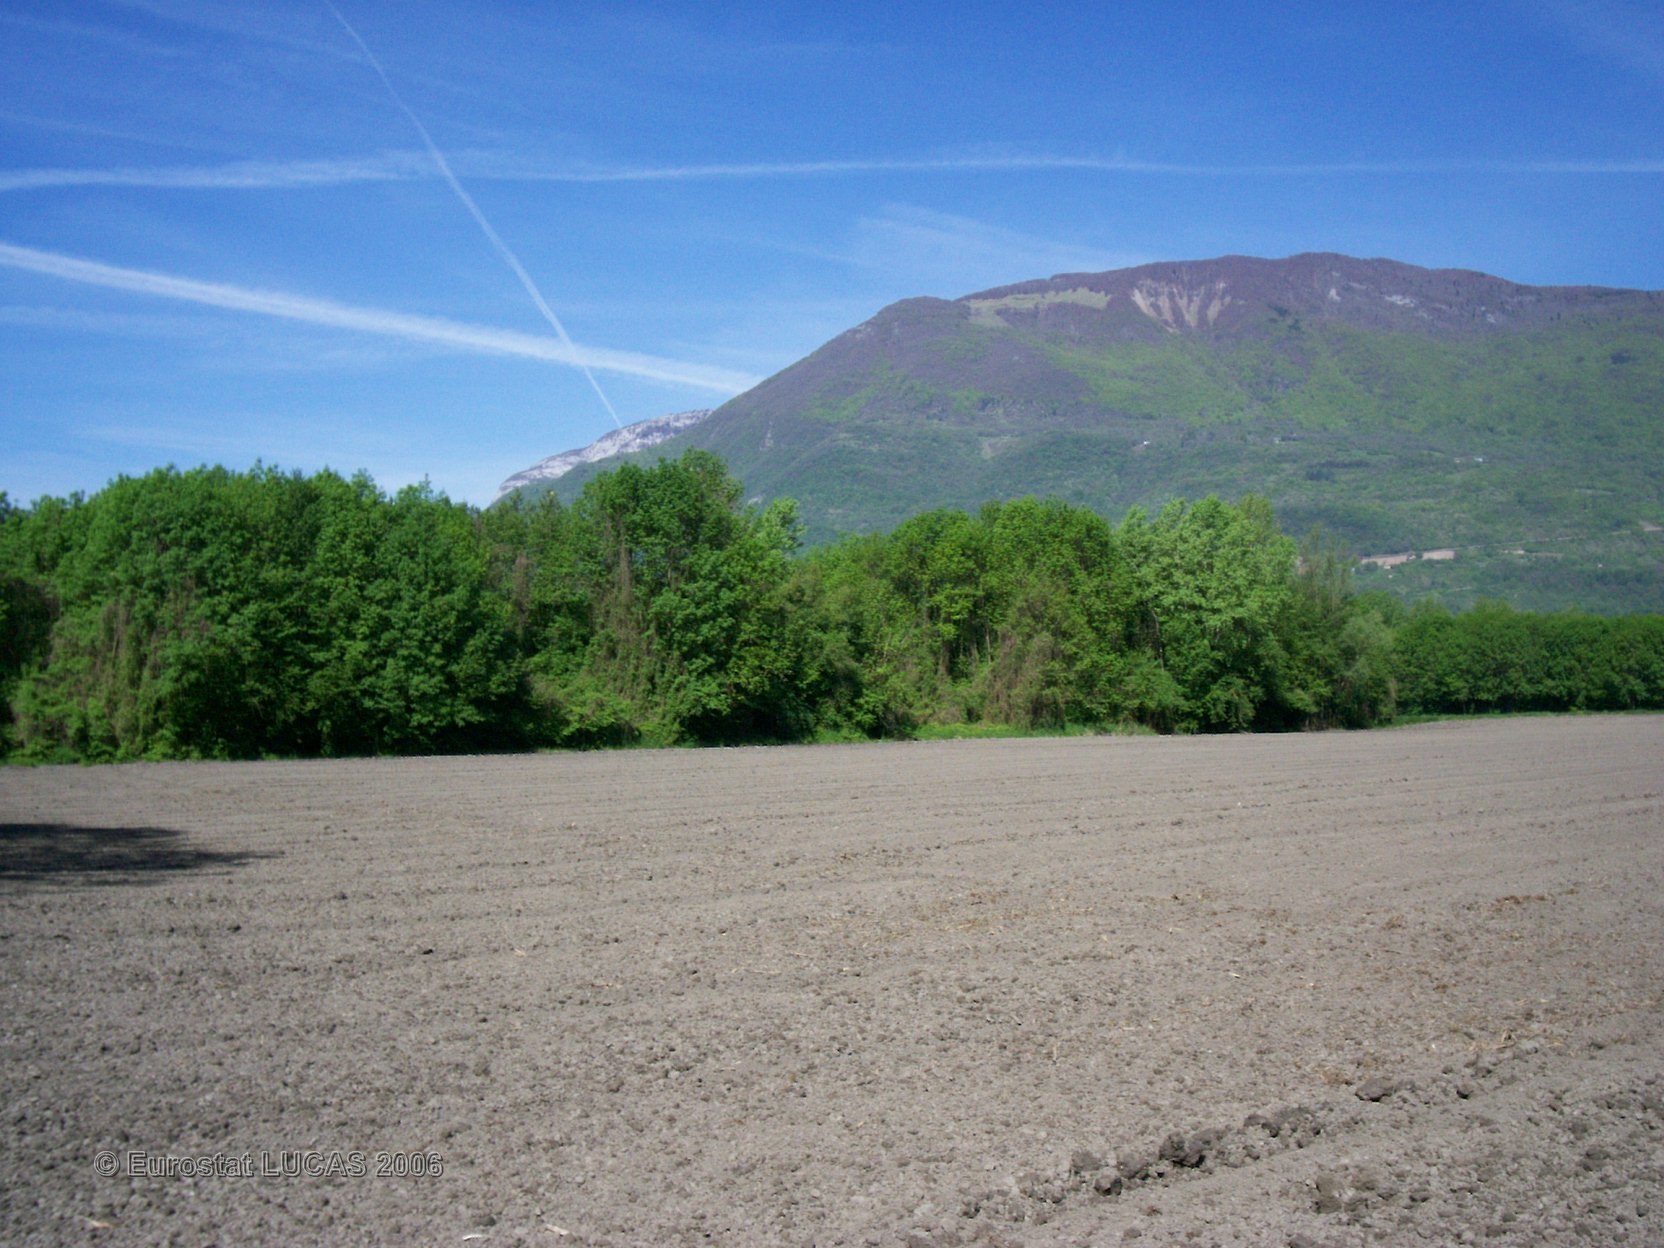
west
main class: Cropland
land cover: Maize
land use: Agriculture (excluding fallow land and kitchen gardens)
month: June
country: FR
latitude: 45.5425
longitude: 6.1496
